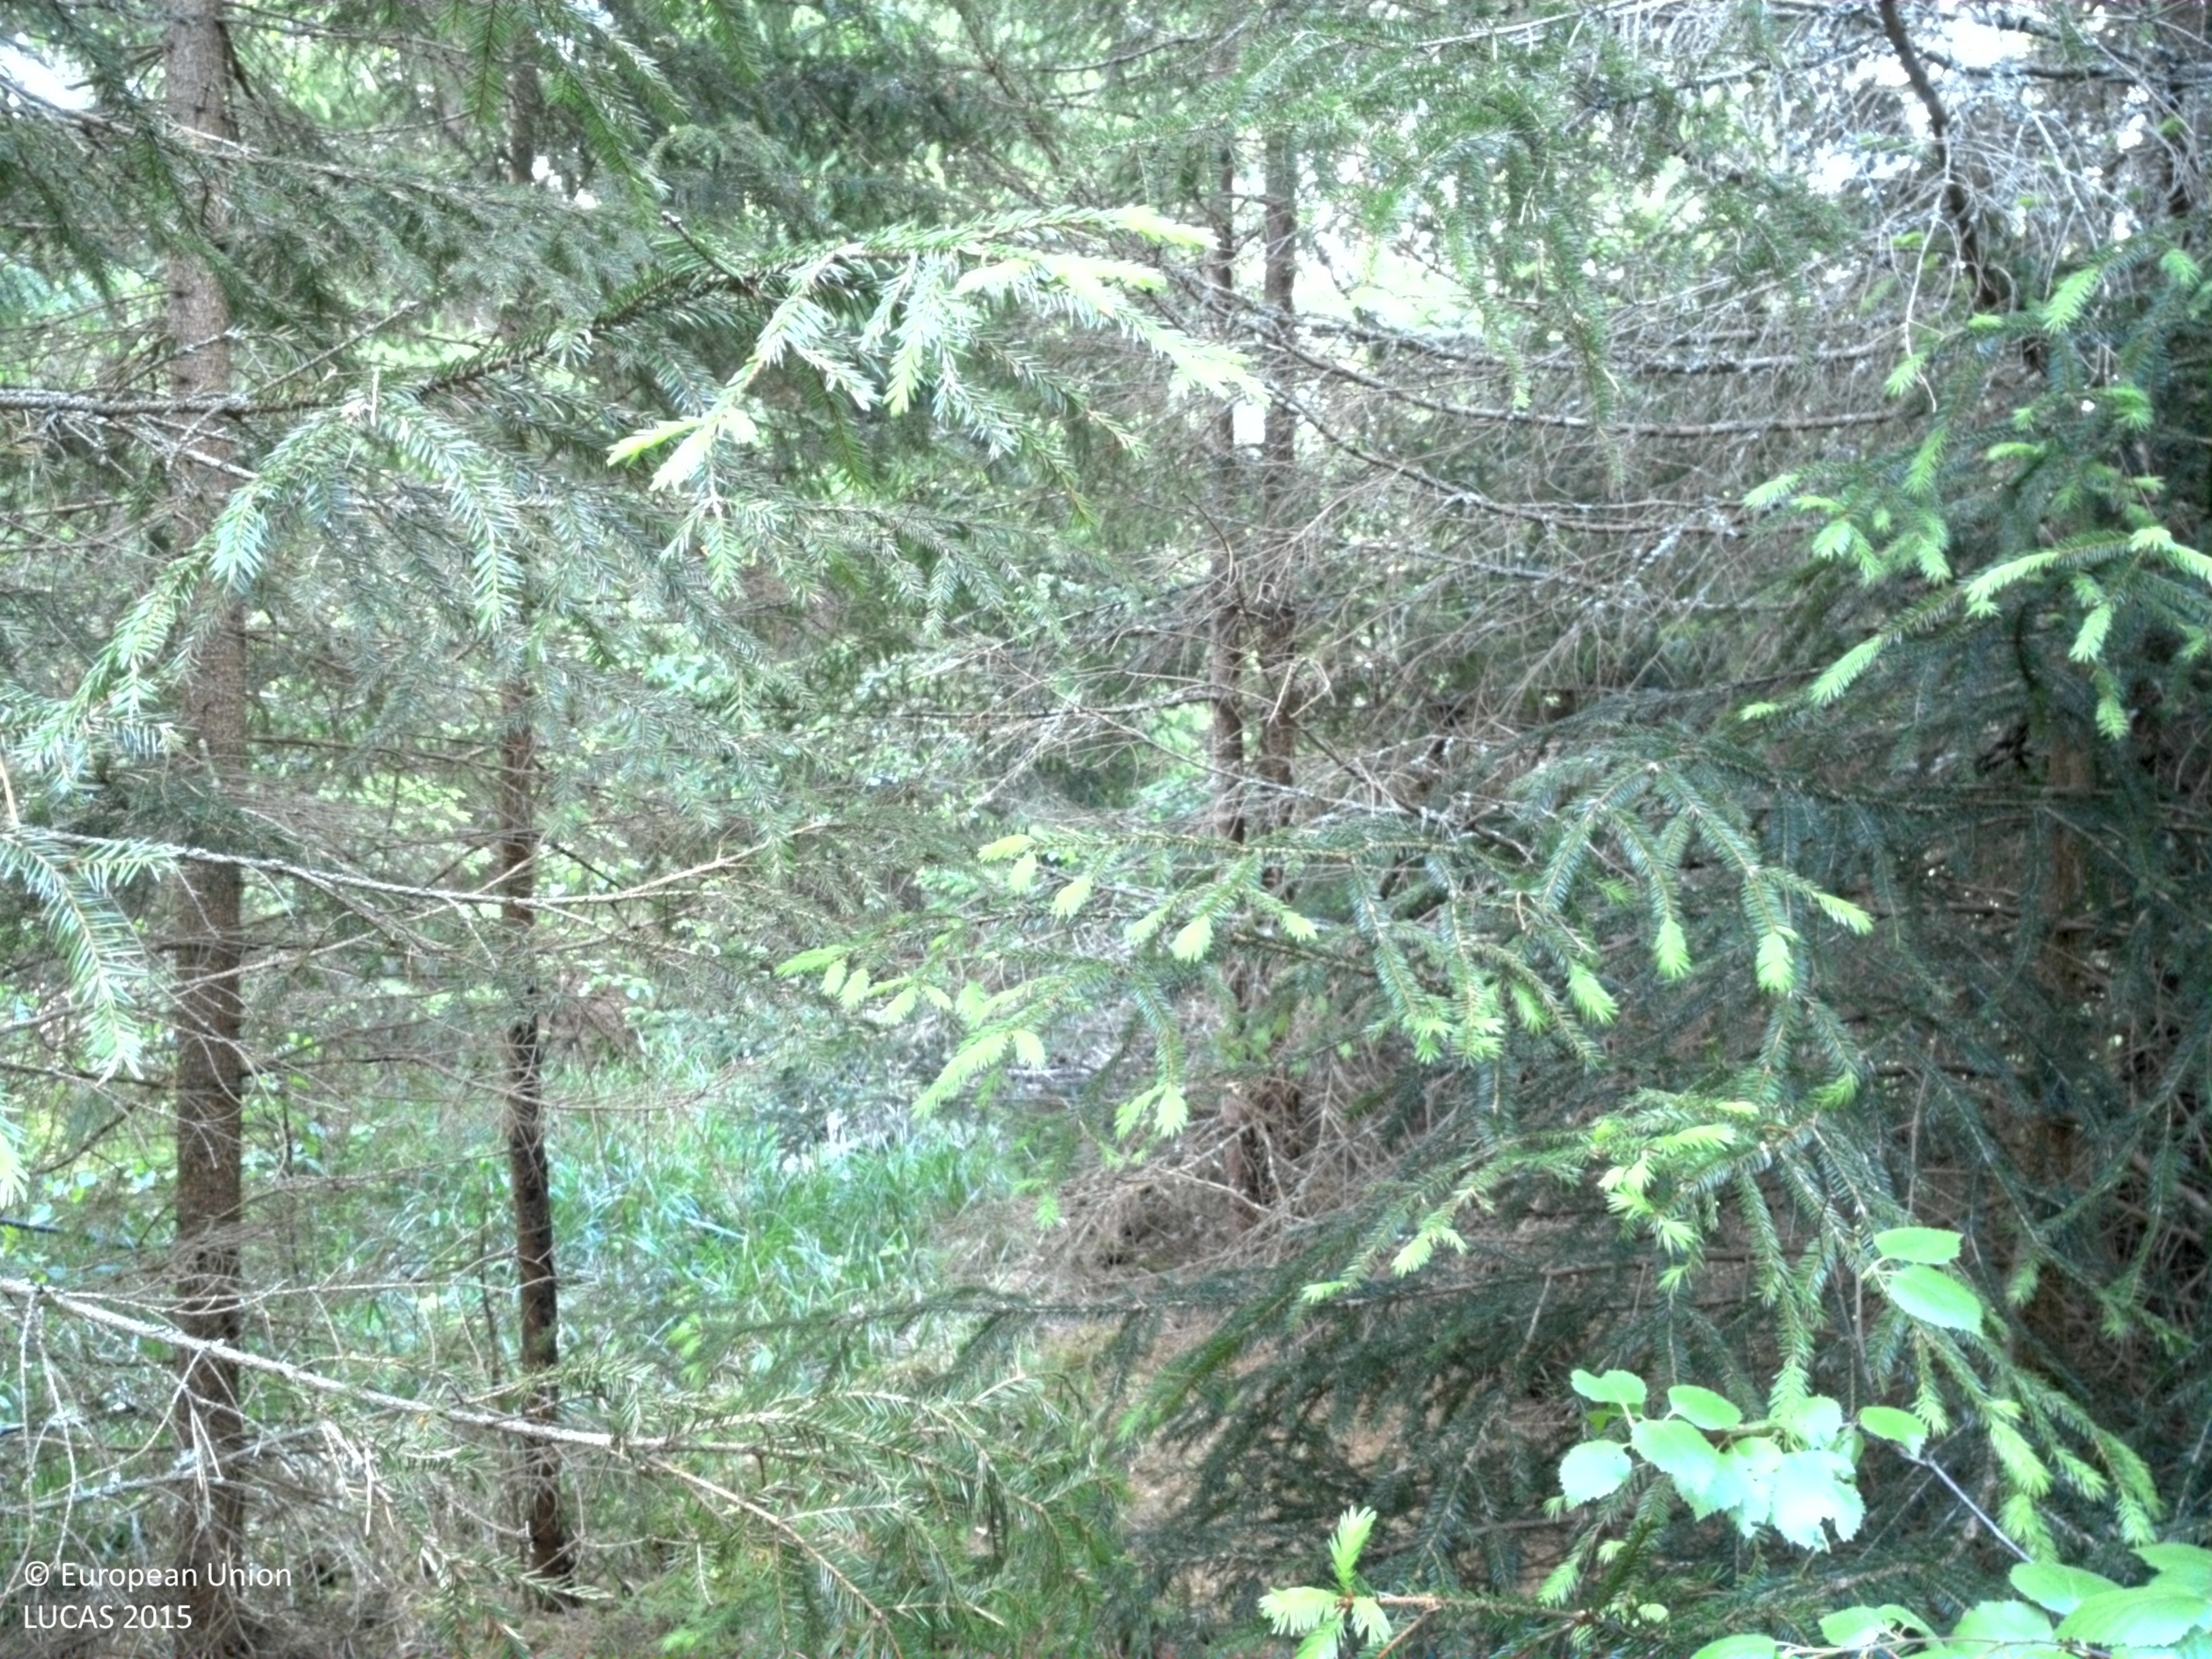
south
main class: Woodland
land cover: Spruce dominated mixed woodland
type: boreal forest
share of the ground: 50 - 75 %
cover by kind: coniferous forest trees 50 %, herbaceous plants 25 %, broadleaved forest trees 20 %, lichens and mosses 5 %
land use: Forestry
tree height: > 5 m
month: June
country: SE
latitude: 60.2393
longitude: 17.0525
